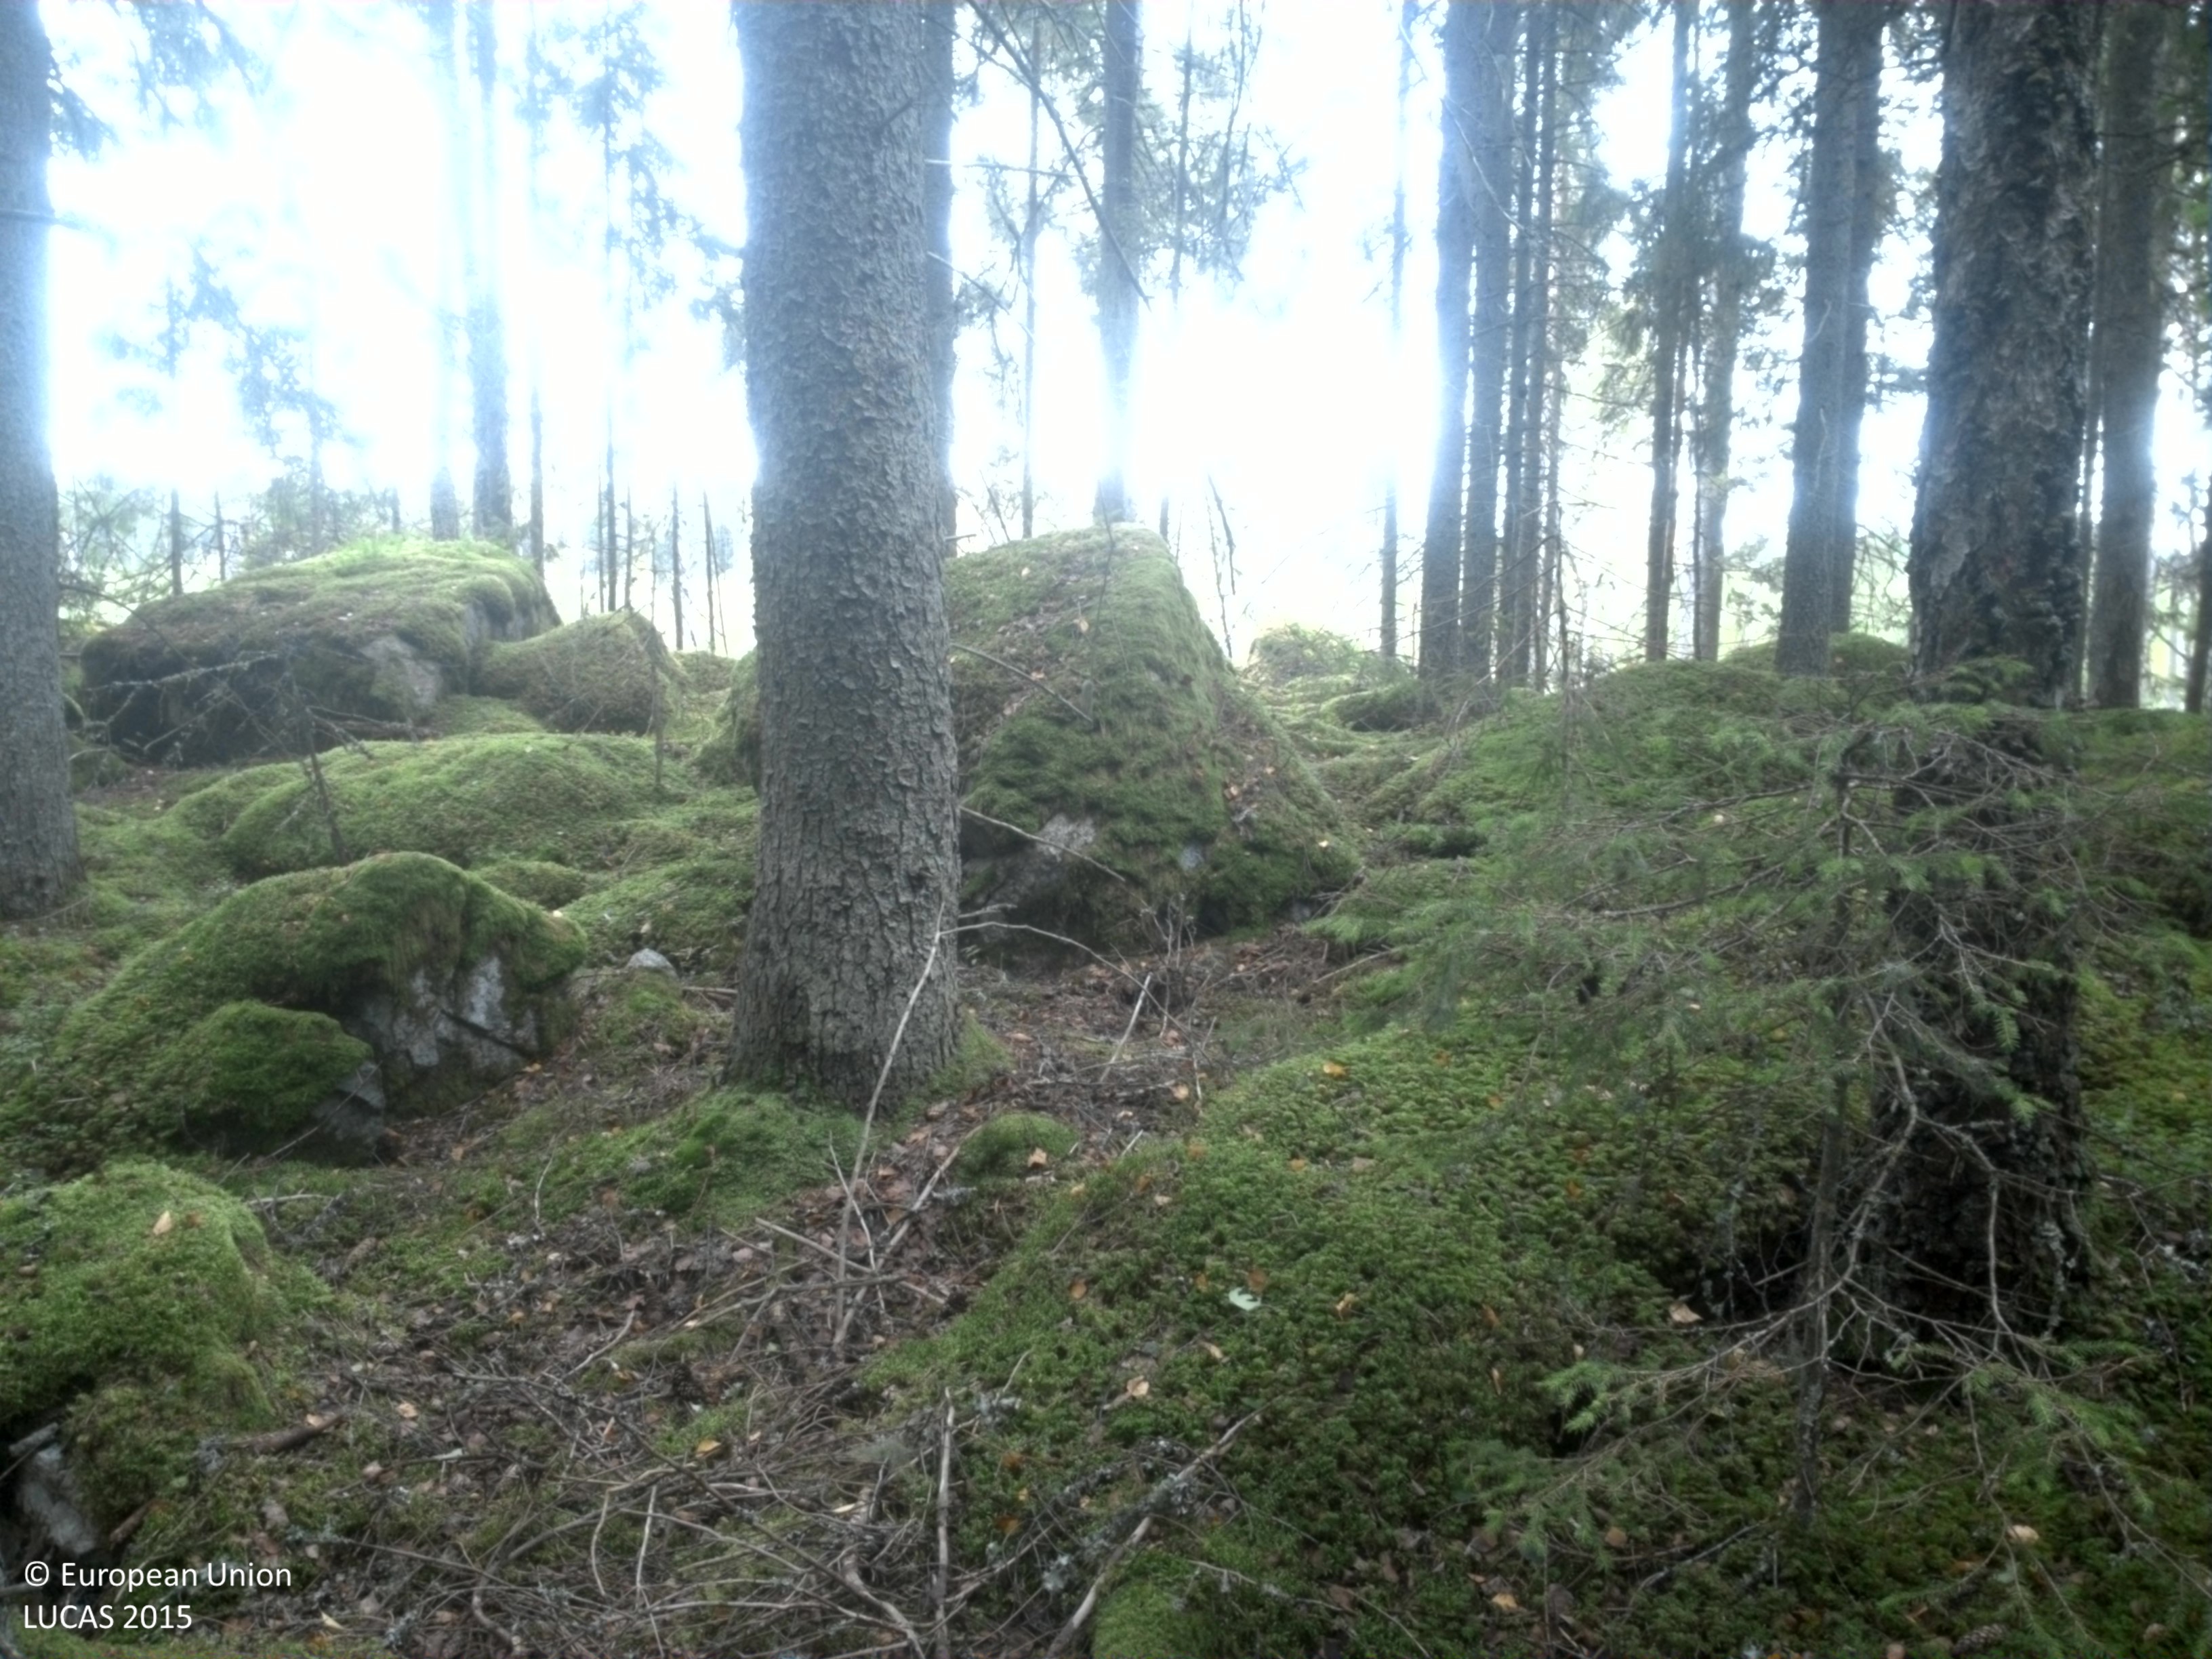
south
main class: Woodland
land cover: Spruce dominated coniferous woodland
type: boreal forest
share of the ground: > 75 %
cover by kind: coniferous forest trees 75 %, lichens and mosses 20 %, shrubs 5 %
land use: Forestry
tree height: > 5 m
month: September
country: SE
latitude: 59.5211
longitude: 15.7711
